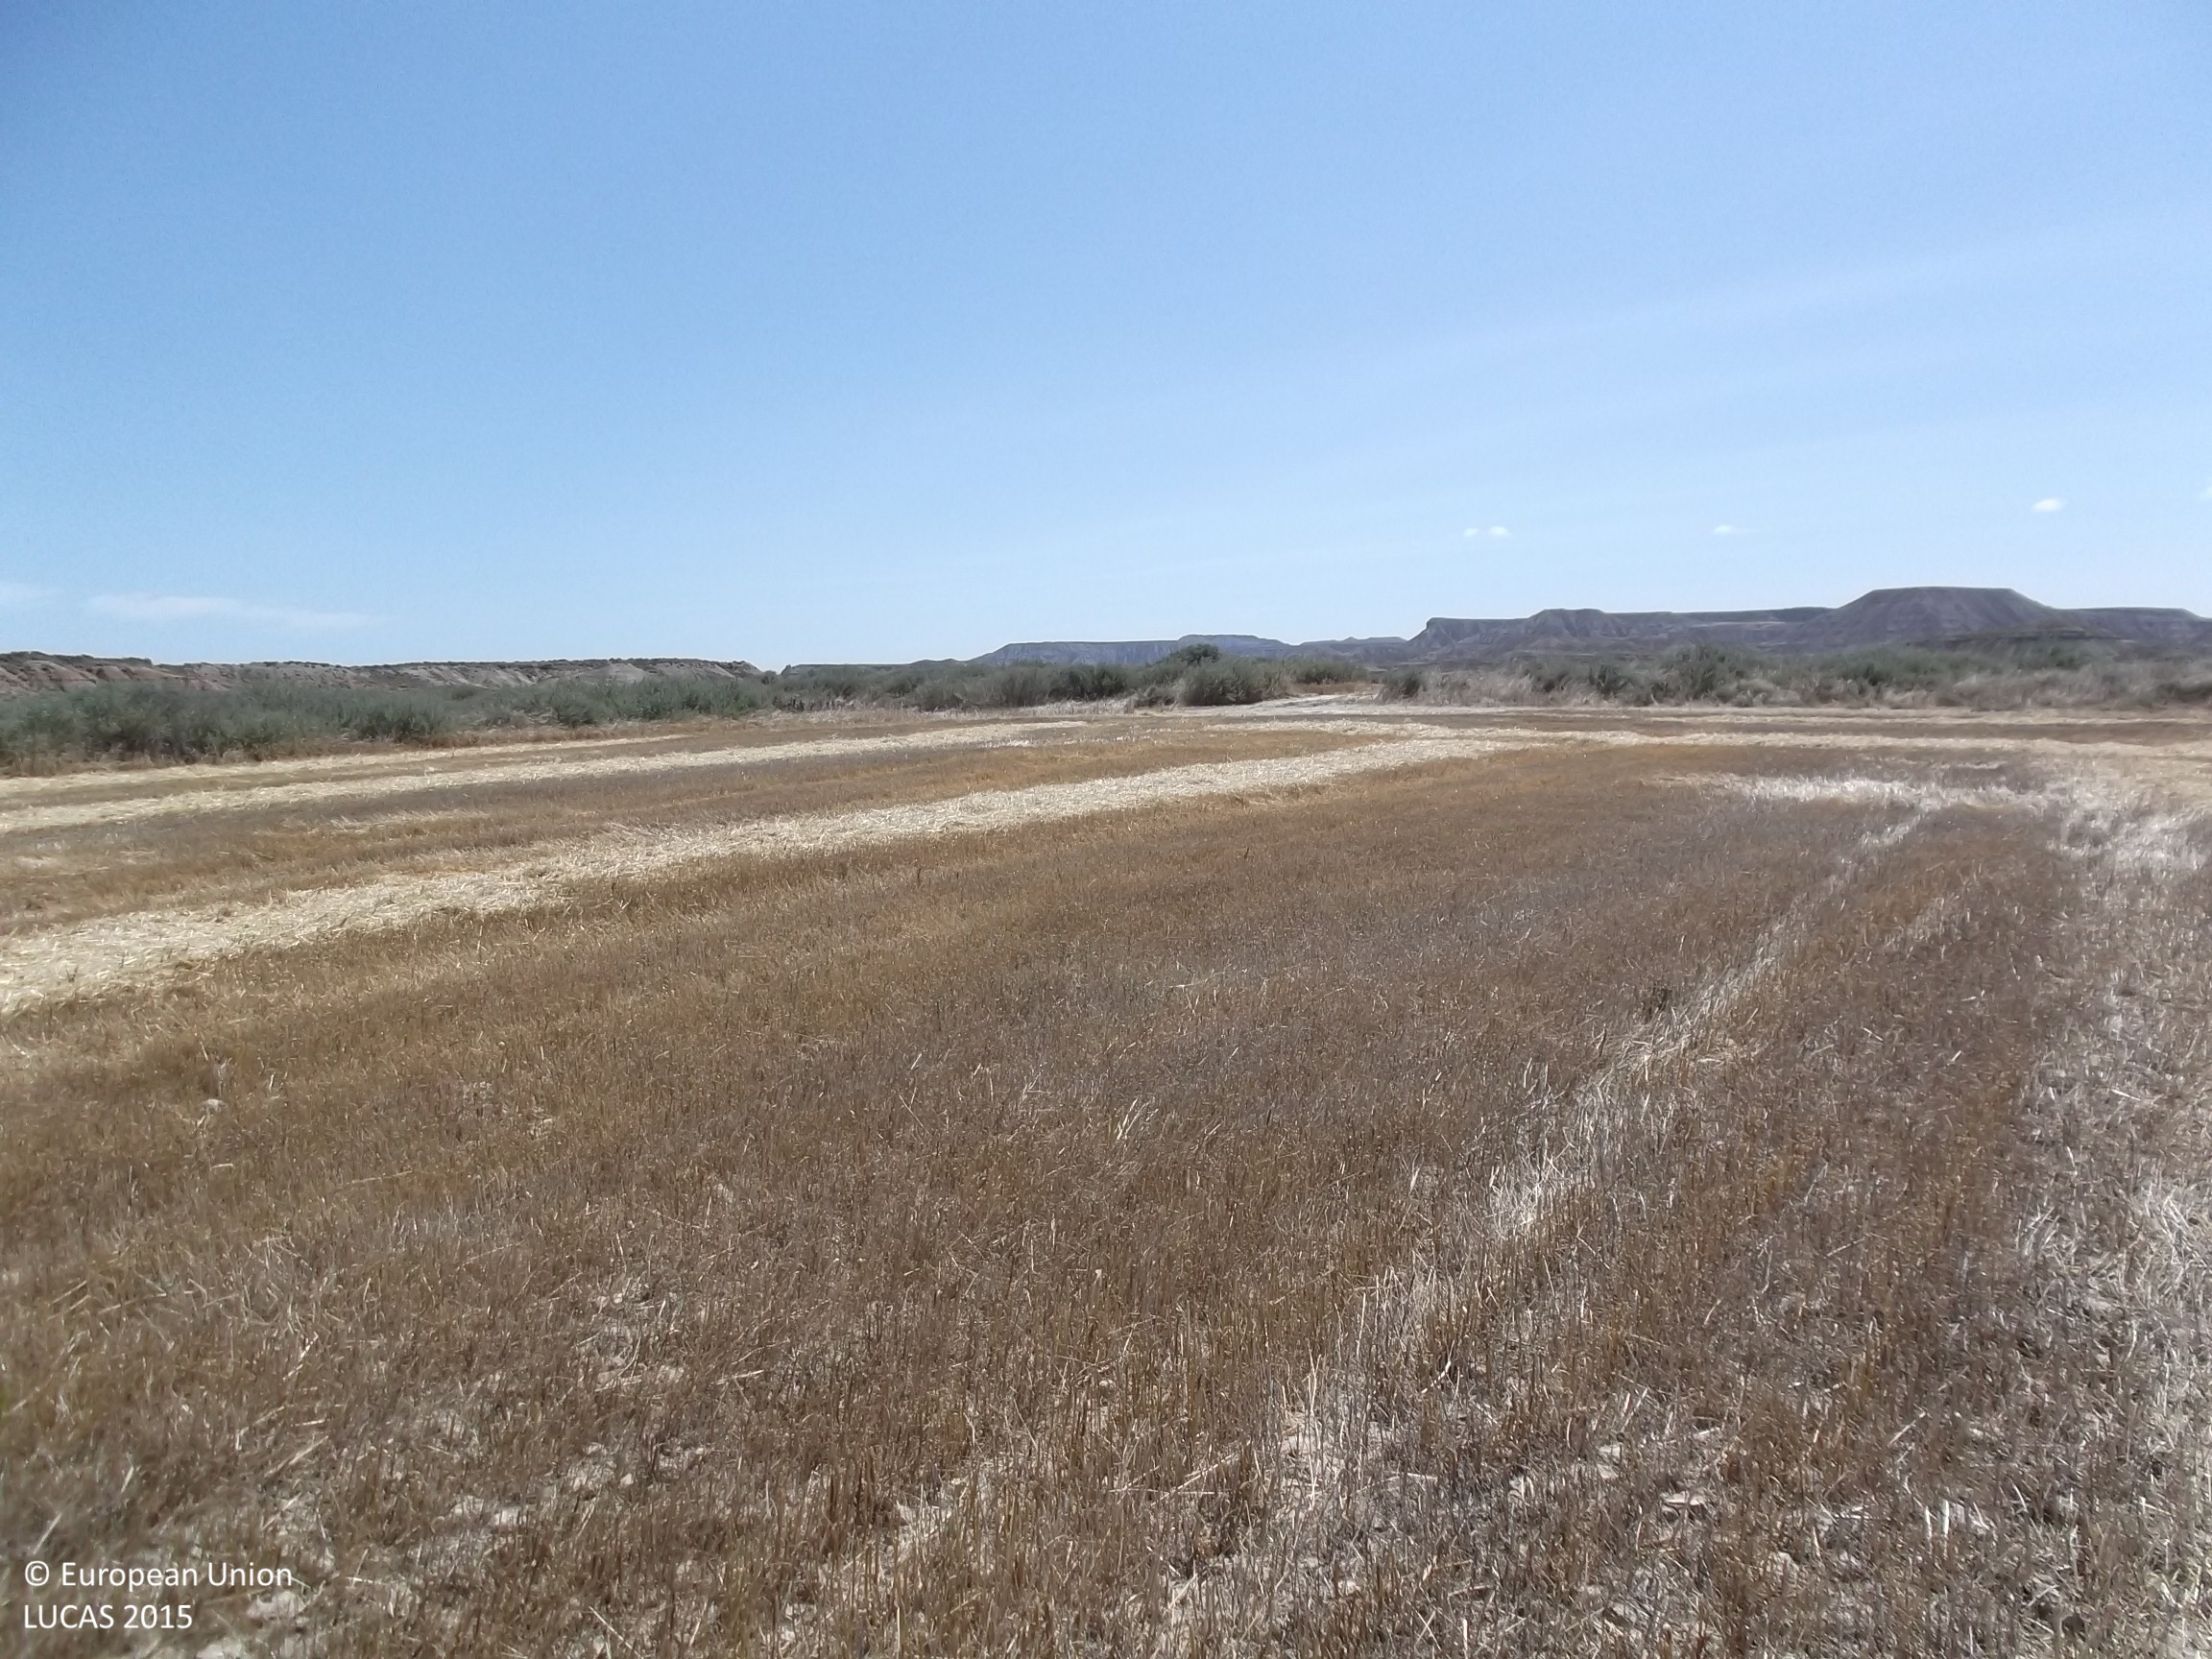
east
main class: Cropland
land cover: Barley
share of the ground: < 10 %
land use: Agriculture (excluding fallow land and kitchen gardens)
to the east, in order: Barley; Shrubland without tree cover; Tracks; Shruby margins; Common wheat; Shruby margins; Barley; Shruby margins; Common wheat; Shrubland without tree cover
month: July
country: ES
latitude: 42.1560
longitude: -1.5415
